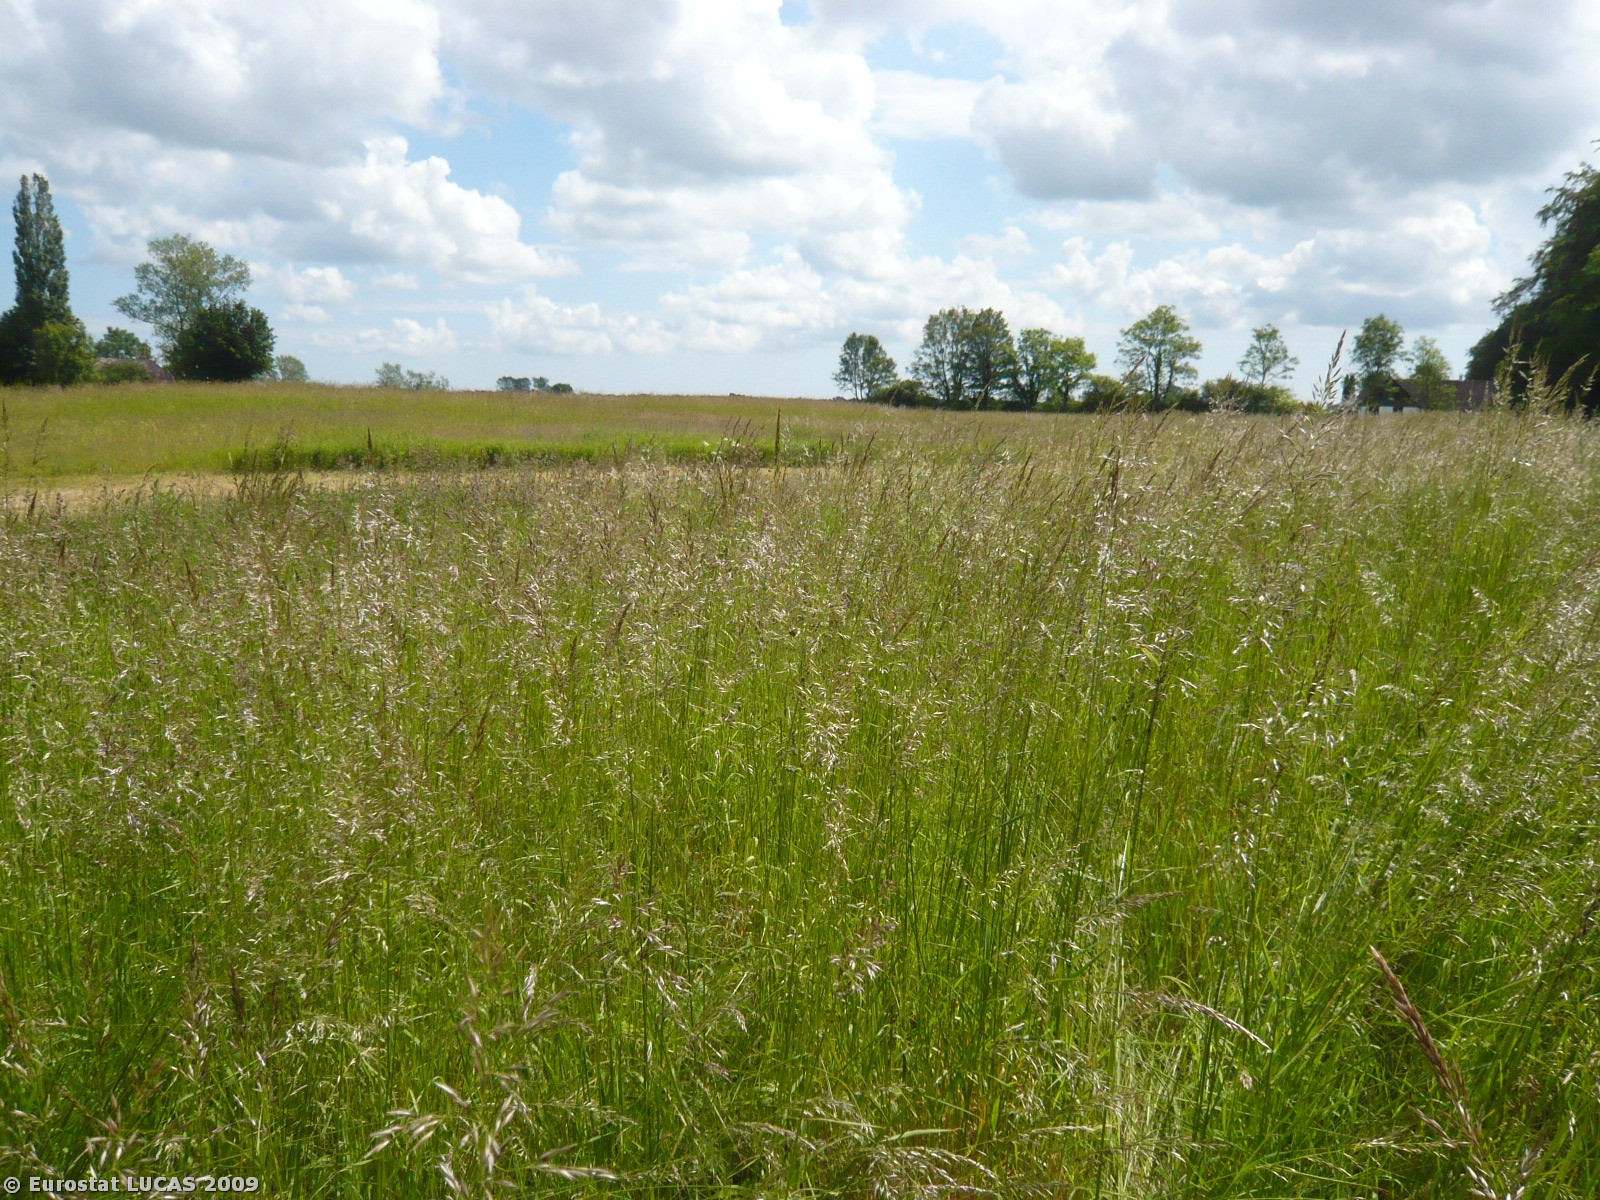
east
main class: Grassland
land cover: Grassland without tree/shrub cover
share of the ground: > 75 %
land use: Agriculture (excluding fallow land and kitchen gardens)
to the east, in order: Grassland without tree/shrub cover; Broadleaved woodland; Paved roads, cycling and walking lanes; Grass margins; Barley
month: June
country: DK
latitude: 54.7563
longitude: 11.6926
